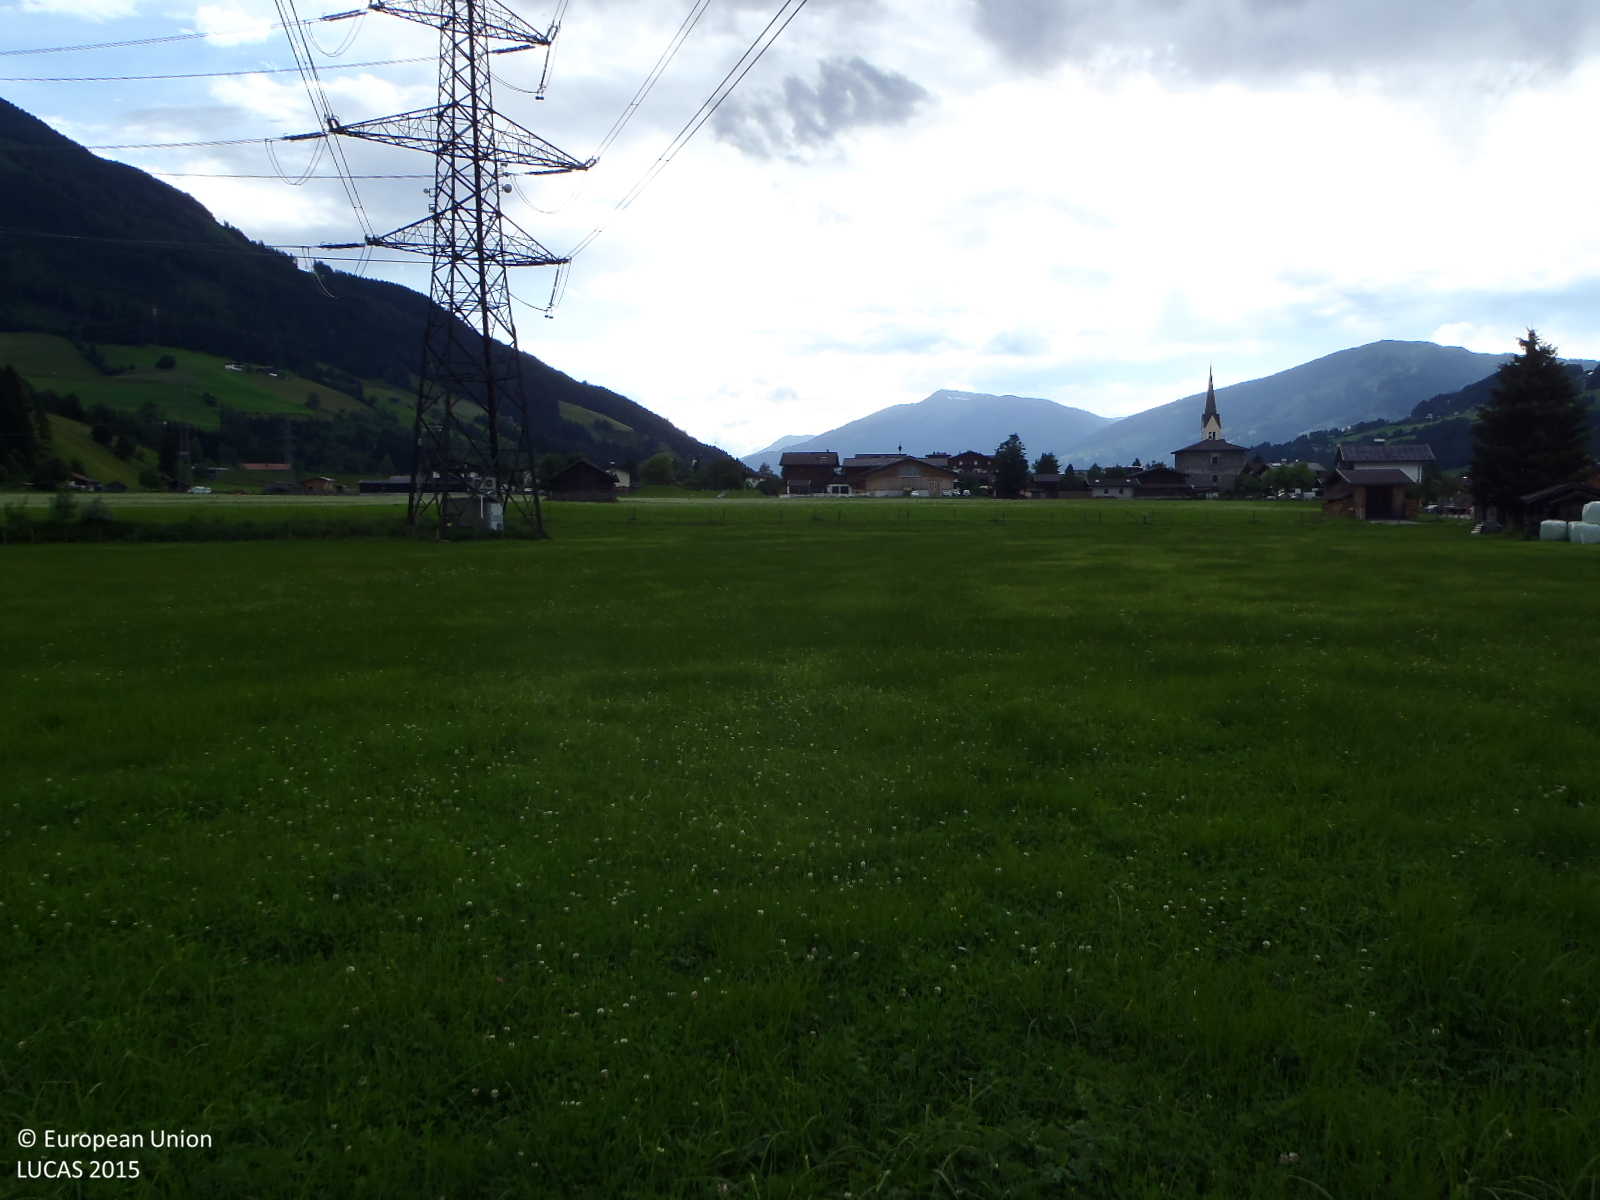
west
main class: Artificial land
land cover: Other artificial areas
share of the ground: > 75 %
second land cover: Grassland without tree/shrub cover
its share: > 75 %
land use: Electricity, gas and thermal power distribution
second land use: Agriculture (excluding fallow land and kitchen gardens)
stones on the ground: < 10 %
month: June
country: AT
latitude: 47.2769
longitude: 12.4966
